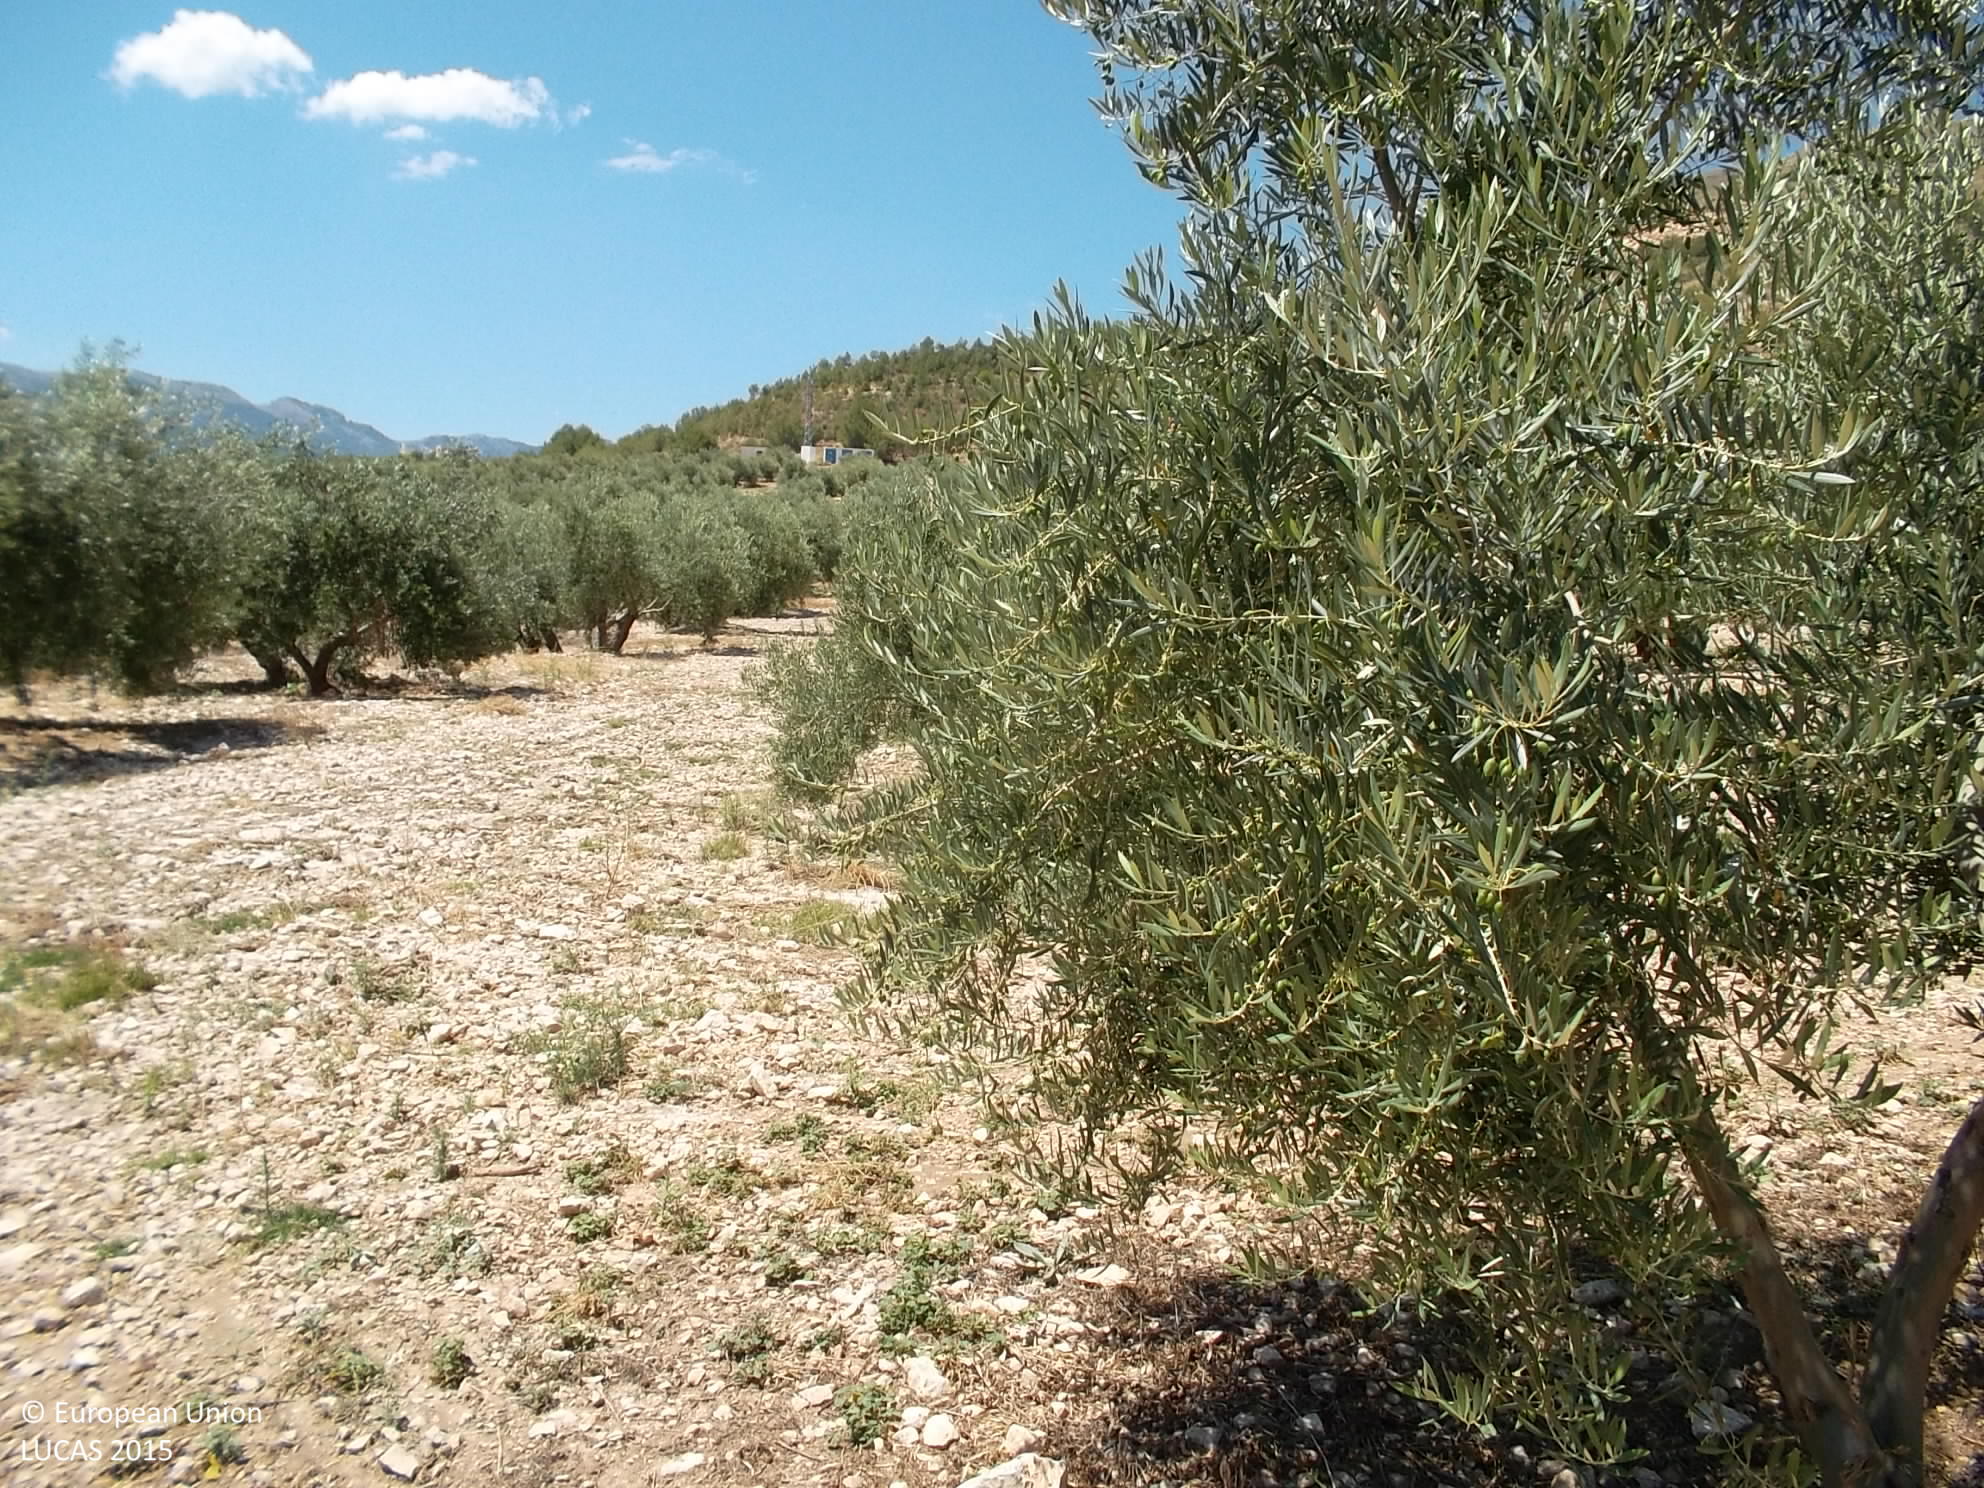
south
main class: Cropland
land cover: Olive groves
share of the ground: 25 - 50 %
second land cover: Grassland without tree/shrub cover
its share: 10 - 25 %
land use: Agriculture (excluding fallow land and kitchen gardens)
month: June
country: ES
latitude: 37.8265
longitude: -3.3694
